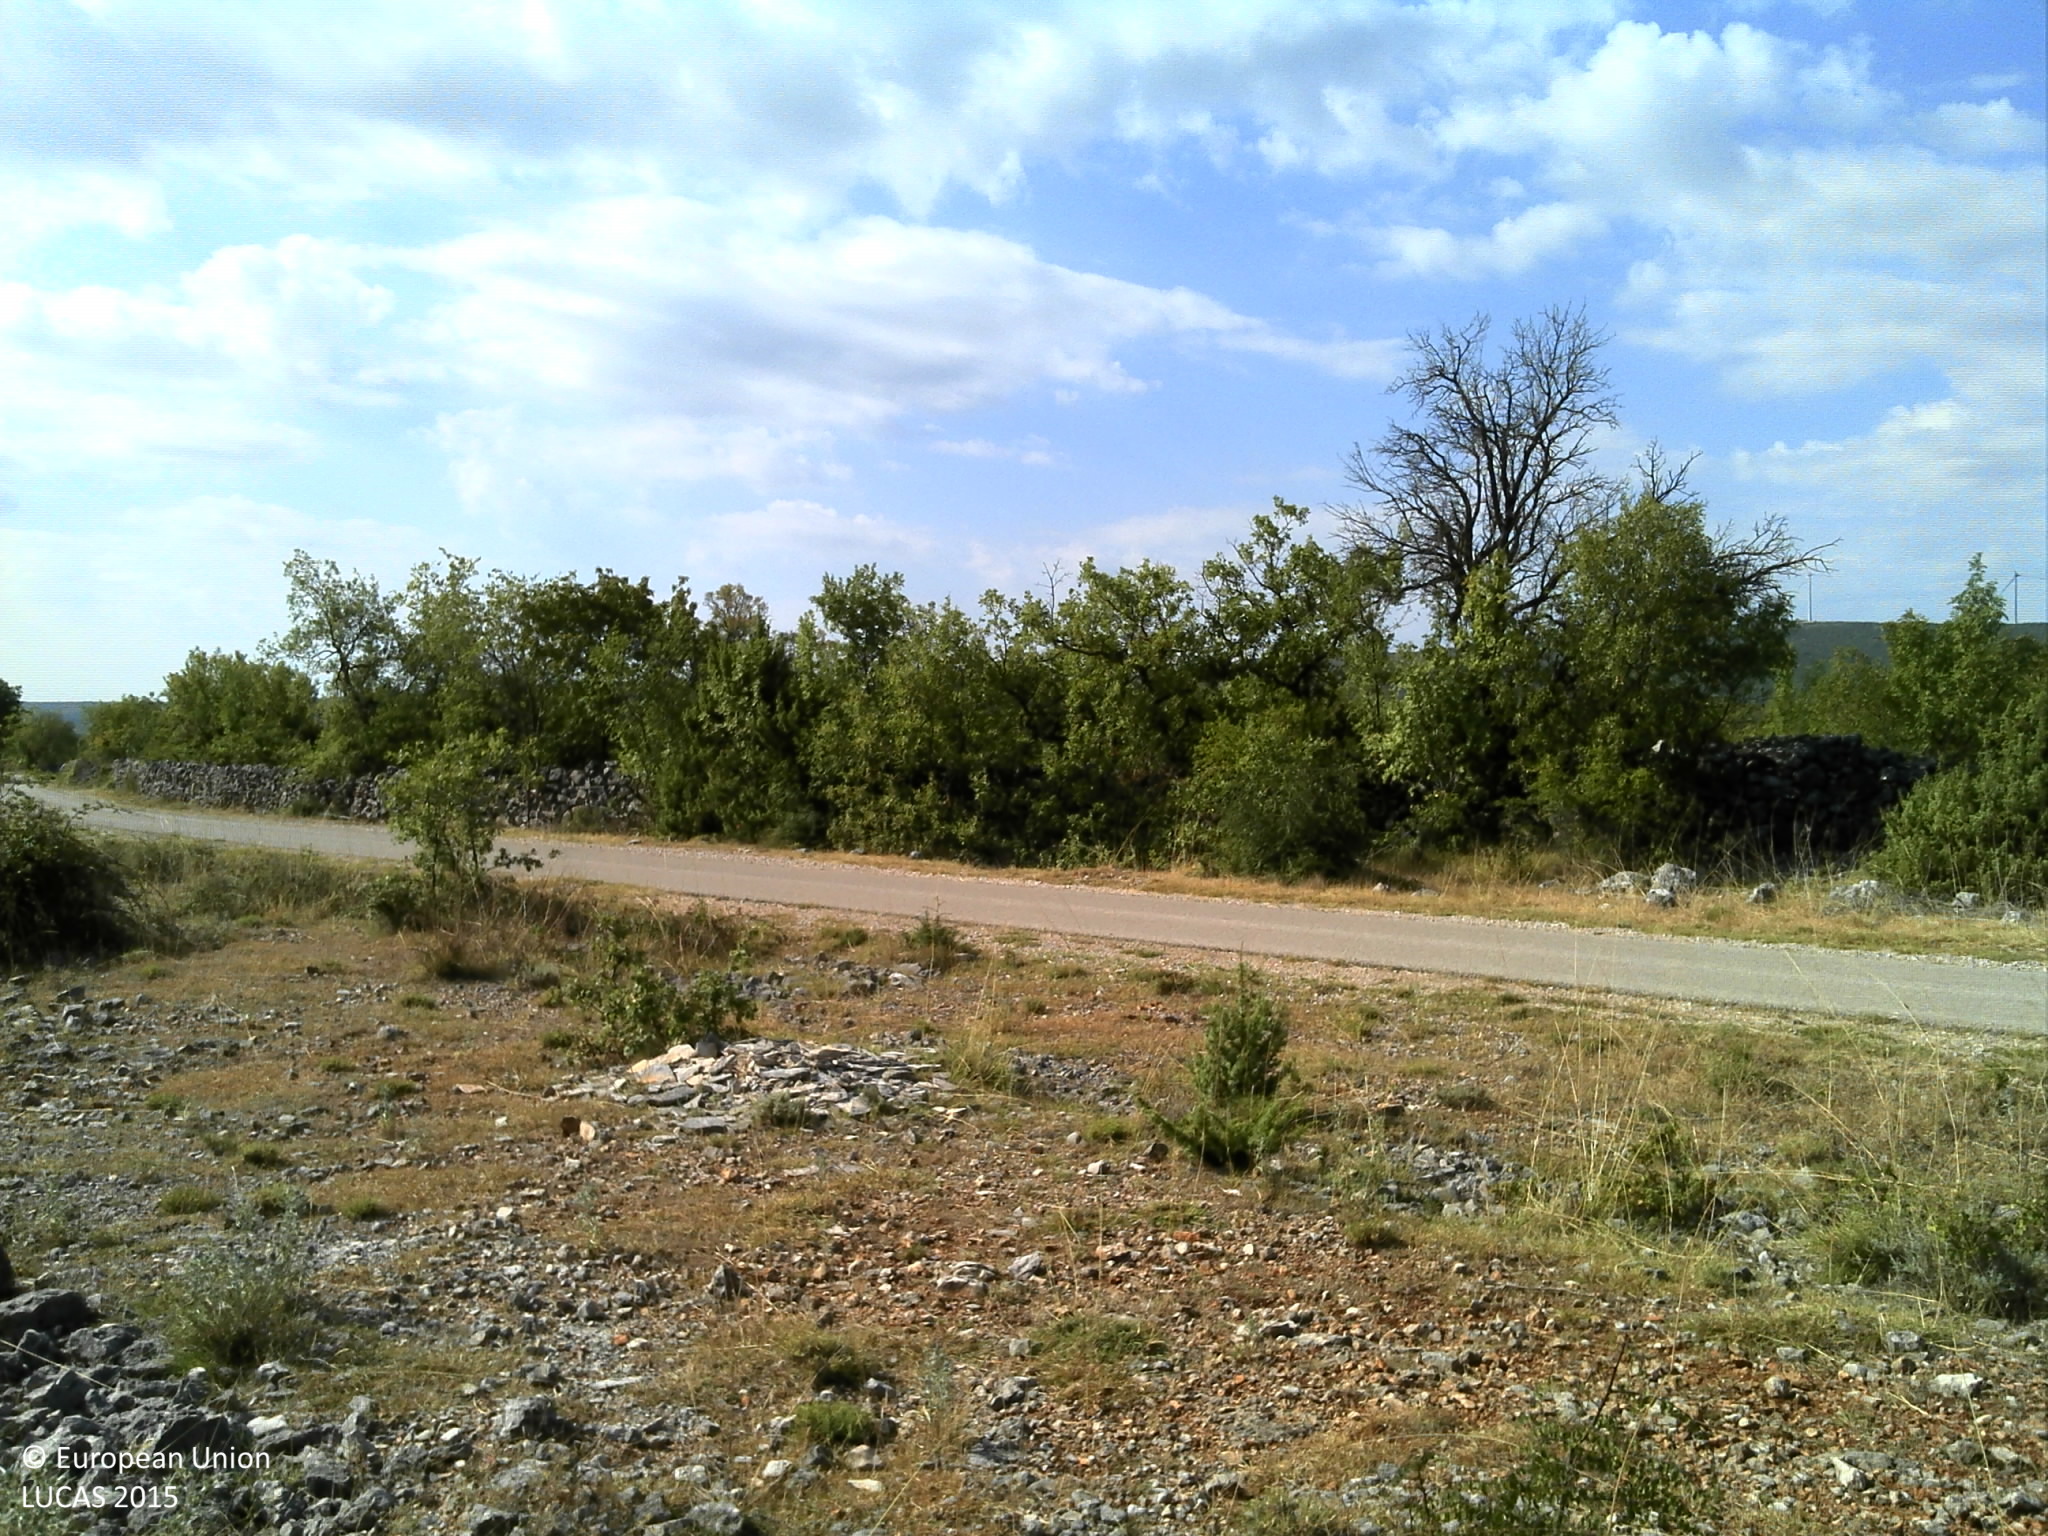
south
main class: Shrubland
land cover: Shrubland without tree cover
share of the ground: 25 - 50 %
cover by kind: unconsolidated bare surface 45 %, shrubs 30 %, herbaceous plants 15 %, consolidated bare surface 10 %
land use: Semi-natural and natural areas not in use
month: July
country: HR
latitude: 43.7737
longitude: 16.0914
